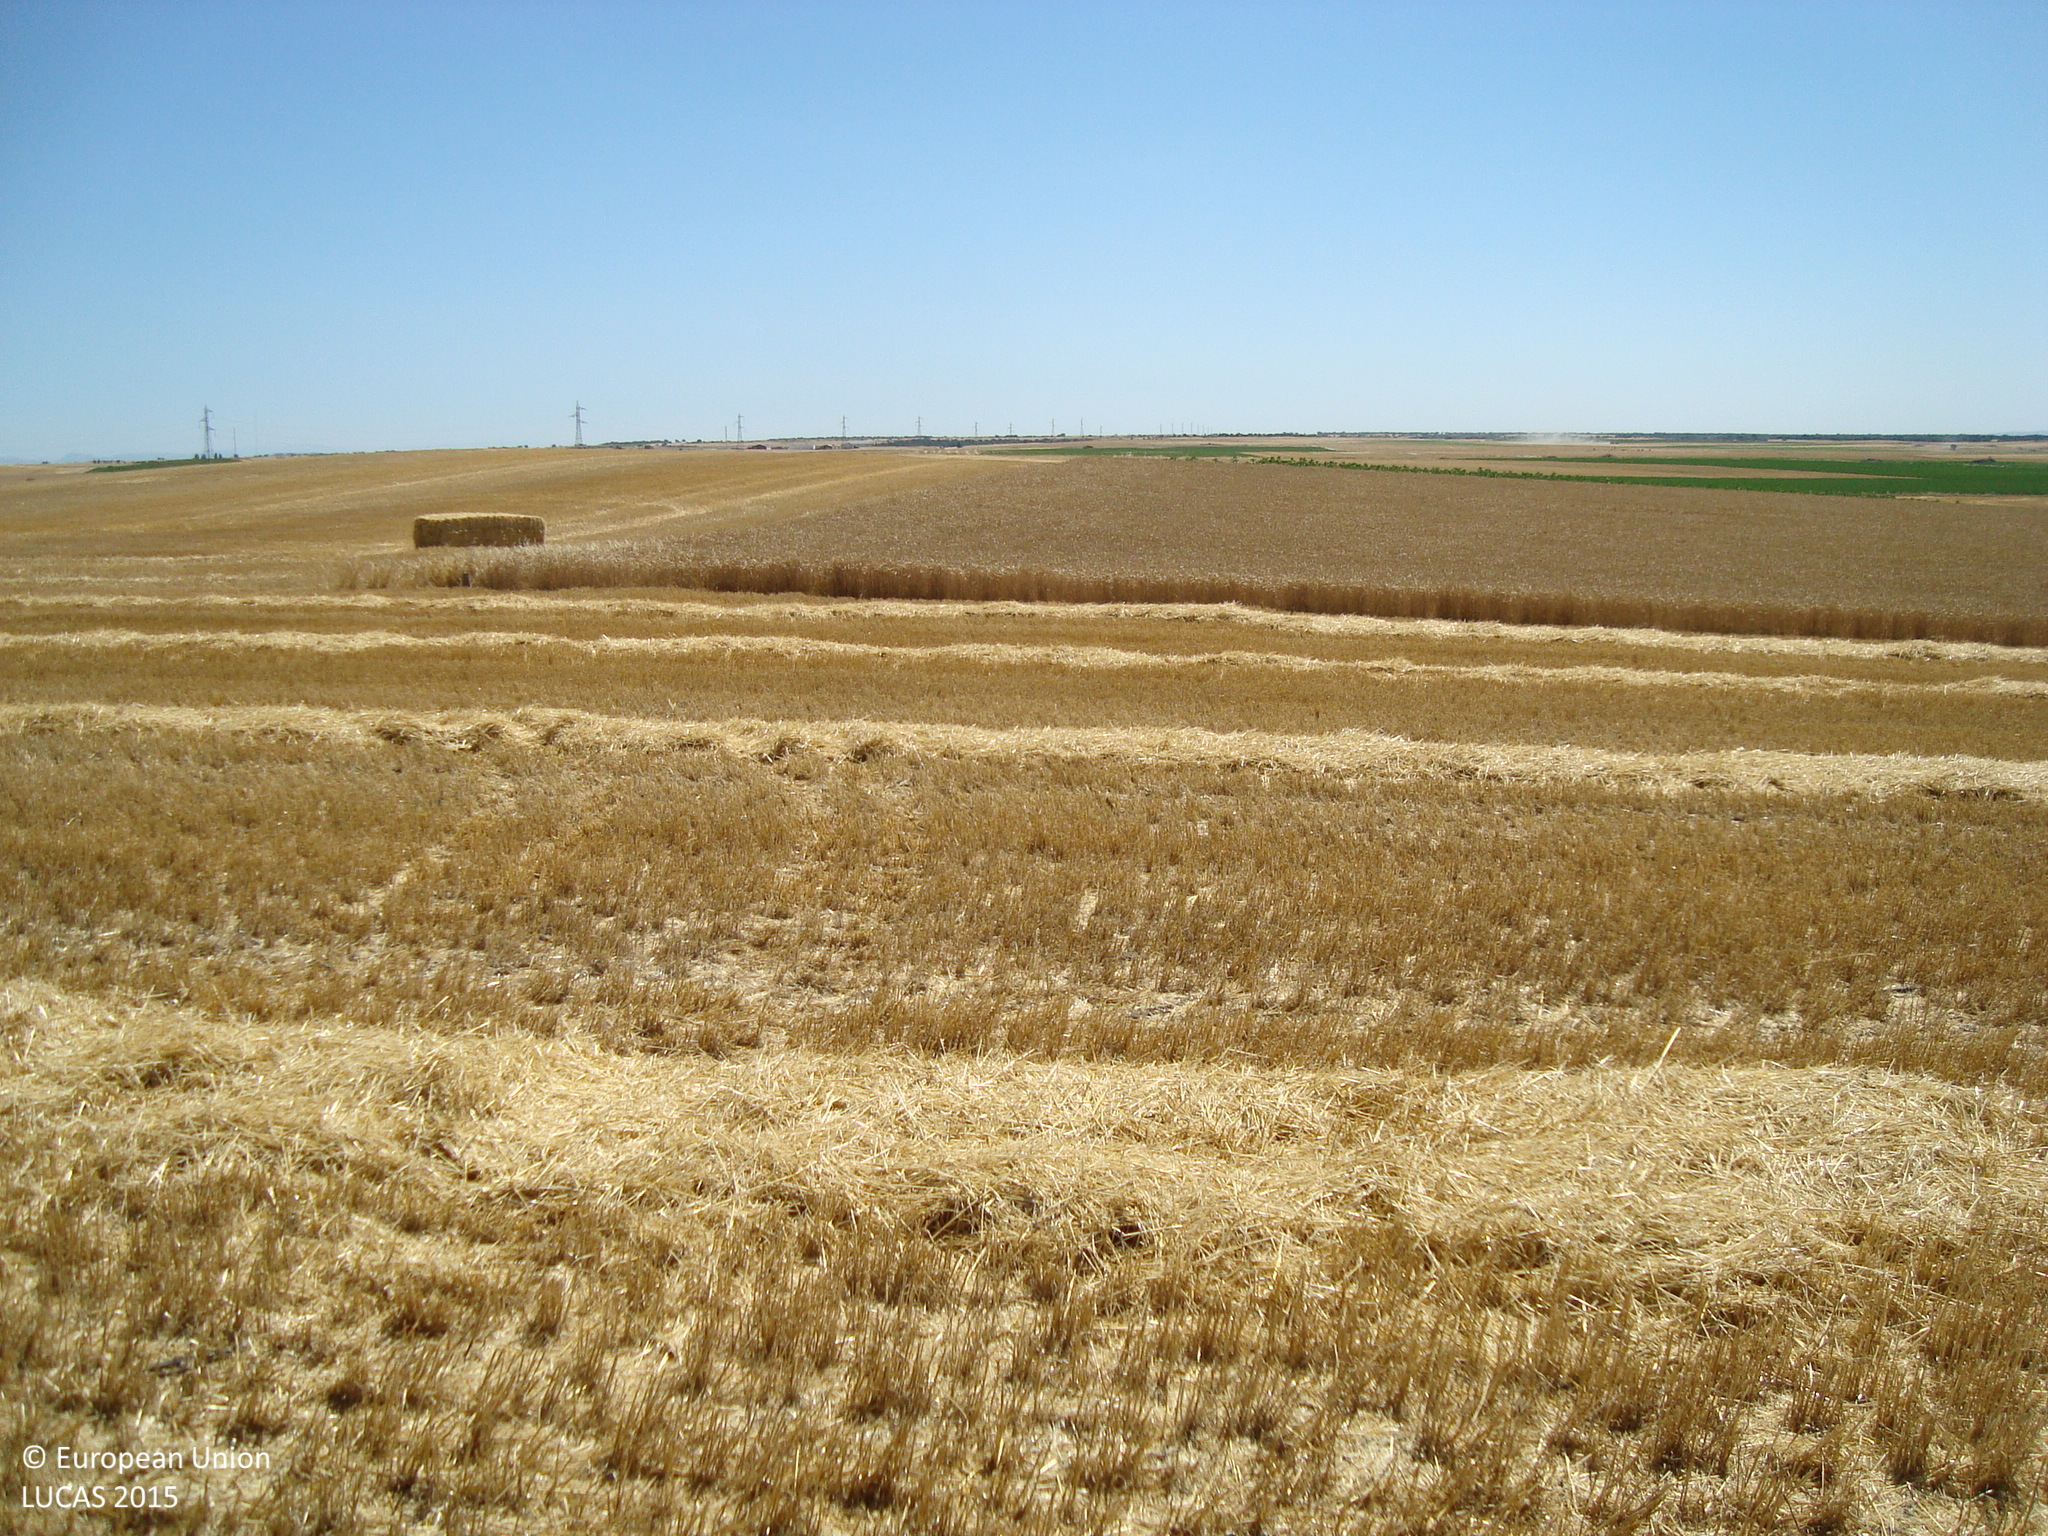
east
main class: Cropland
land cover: Barley
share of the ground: < 10 %
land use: Agriculture (excluding fallow land and kitchen gardens)
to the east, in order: Barley; Common wheat; Barley
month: July
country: ES
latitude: 41.6801
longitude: -4.1021
